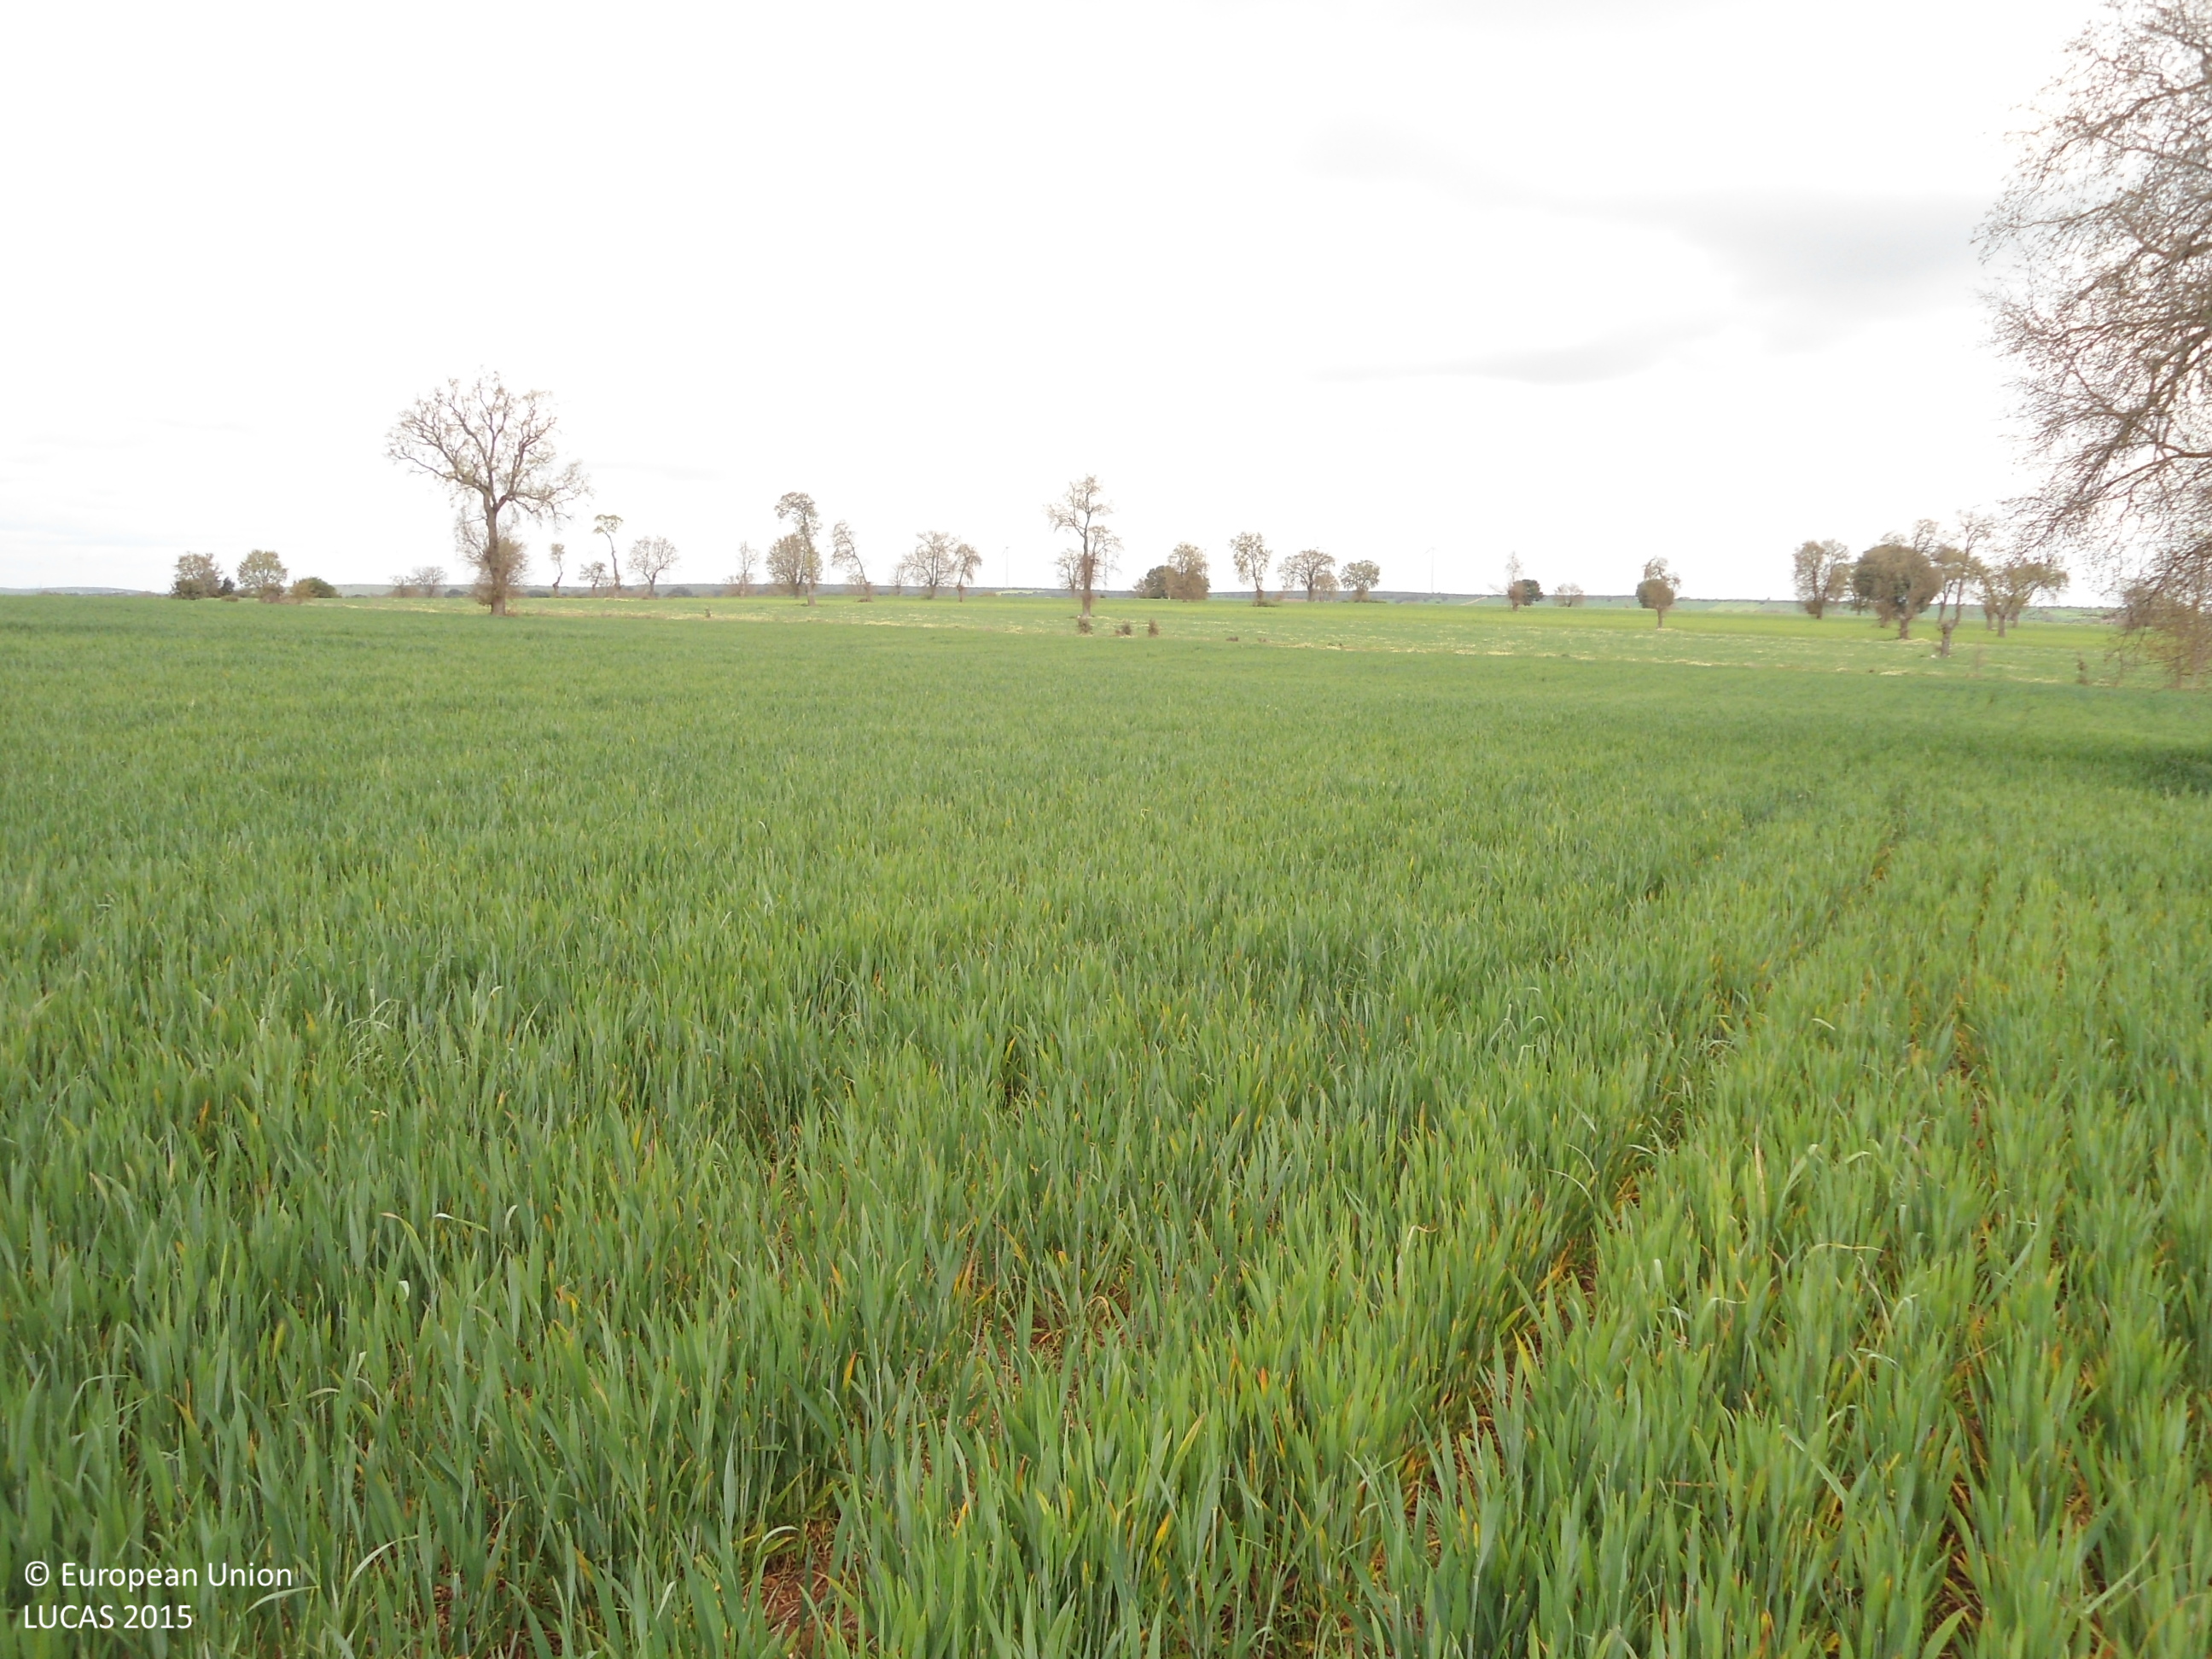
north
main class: Cropland
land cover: Common wheat
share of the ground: > 75 %
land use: Agriculture (excluding fallow land and kitchen gardens)
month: April
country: ES
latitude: 41.6138
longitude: -5.8712
